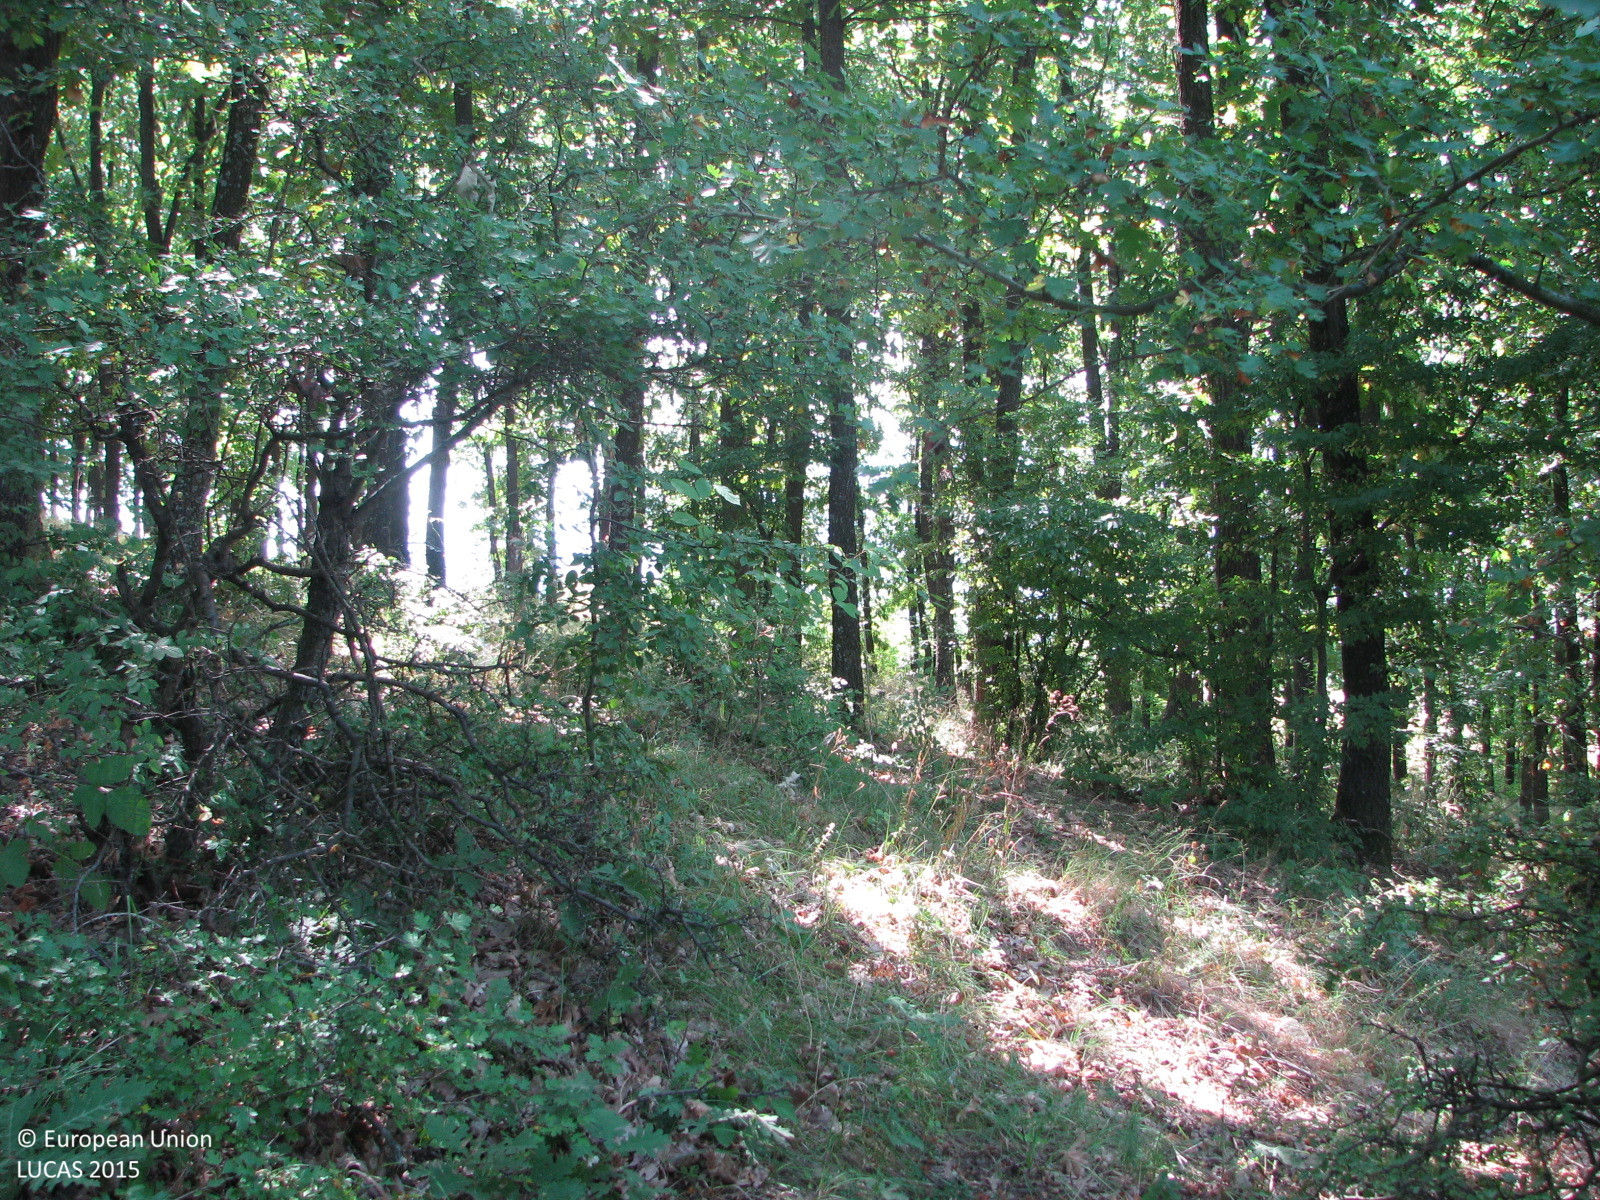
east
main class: Woodland
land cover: Broadleaved woodland
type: thermophilous deciduous forest
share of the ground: 25 - 50 %
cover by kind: herbaceous plants 50 %, broadleaved forest trees 40 %, shrubs 10 %
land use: Forestry
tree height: > 5 m
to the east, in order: Broadleaved woodland; Rock outcrops; Tracks; Rocks and stones; Broadleaved woodland; Tracks; Lines of trees; Other fruit trees and berries; Artificial constructions; Grassland without tree/shrub cover; Tracks; Grassland without tree/shrub cover
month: August
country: BG
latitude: 42.7659
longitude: 26.1325
